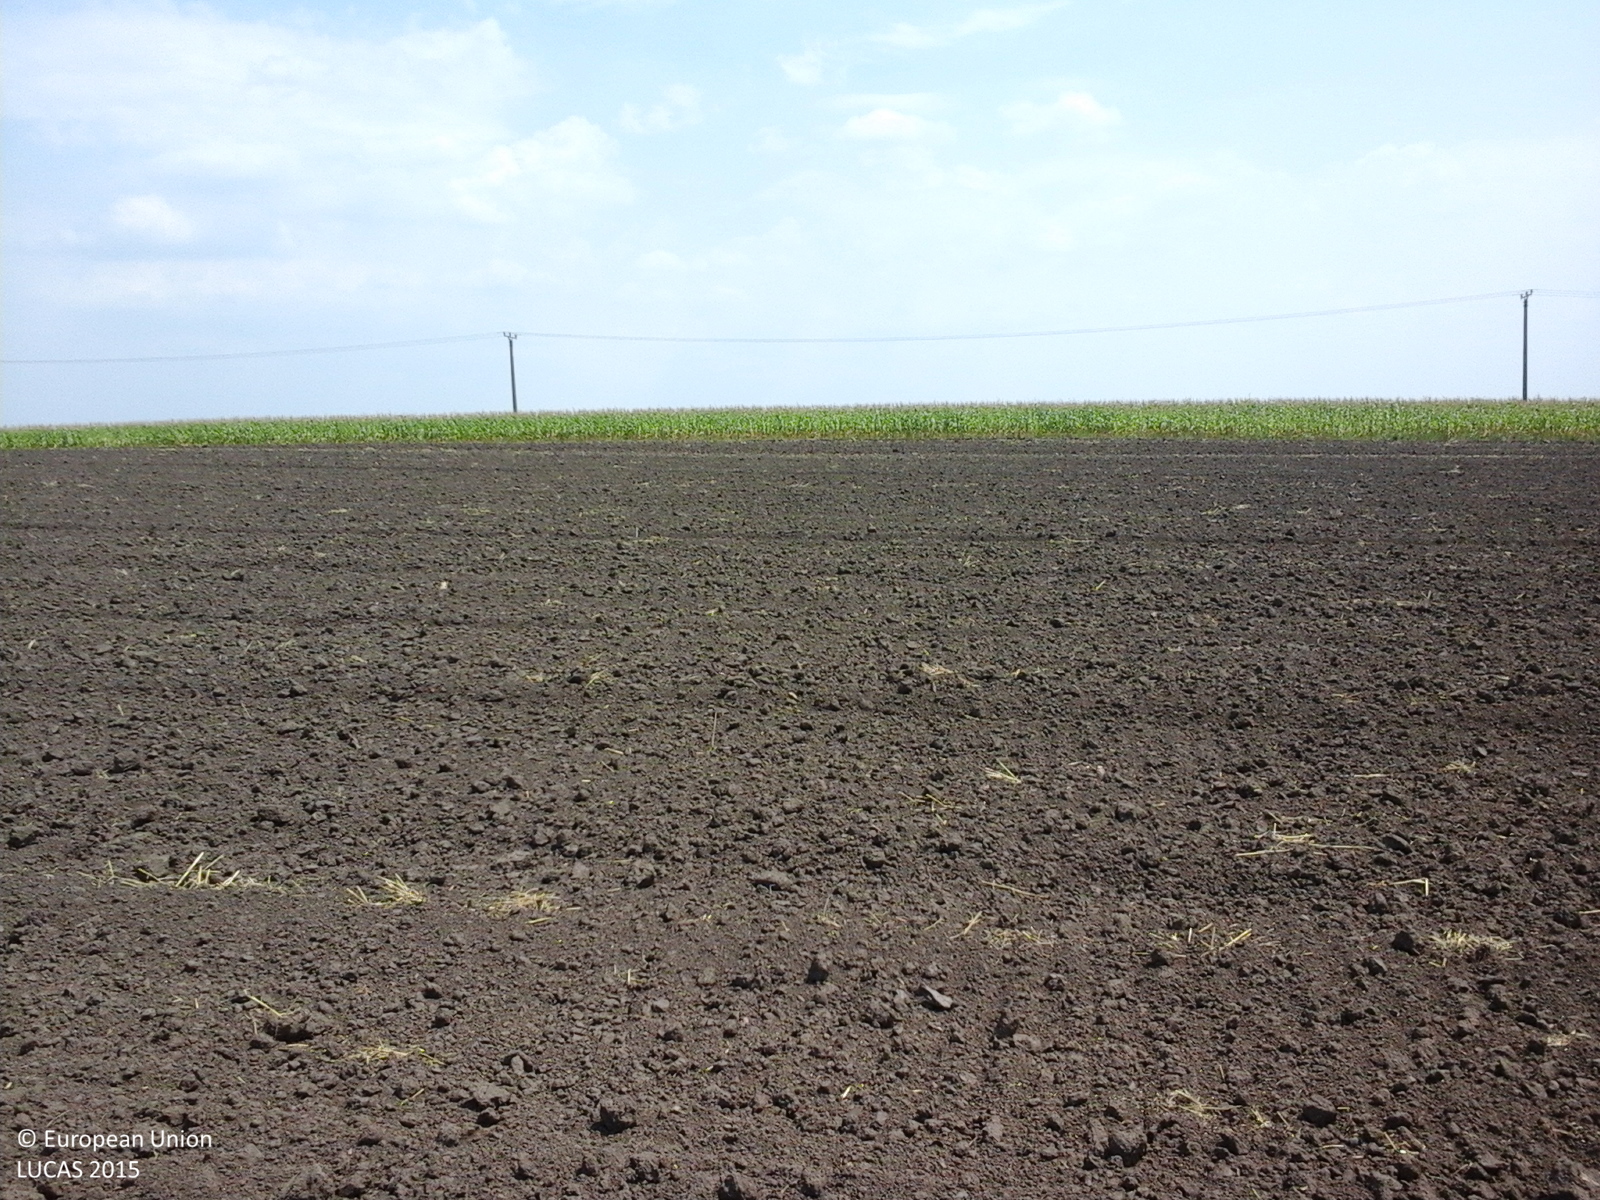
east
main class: Cropland
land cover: Common wheat
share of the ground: < 10 %
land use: Agriculture (excluding fallow land and kitchen gardens)
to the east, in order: Common wheat; Maize; Other bare soil; Electric lines; Grass margins; Tracks; Spontaneously vegetated surfaces; Maize; Sunflower
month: July
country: RO
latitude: 45.8858
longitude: 27.5151
